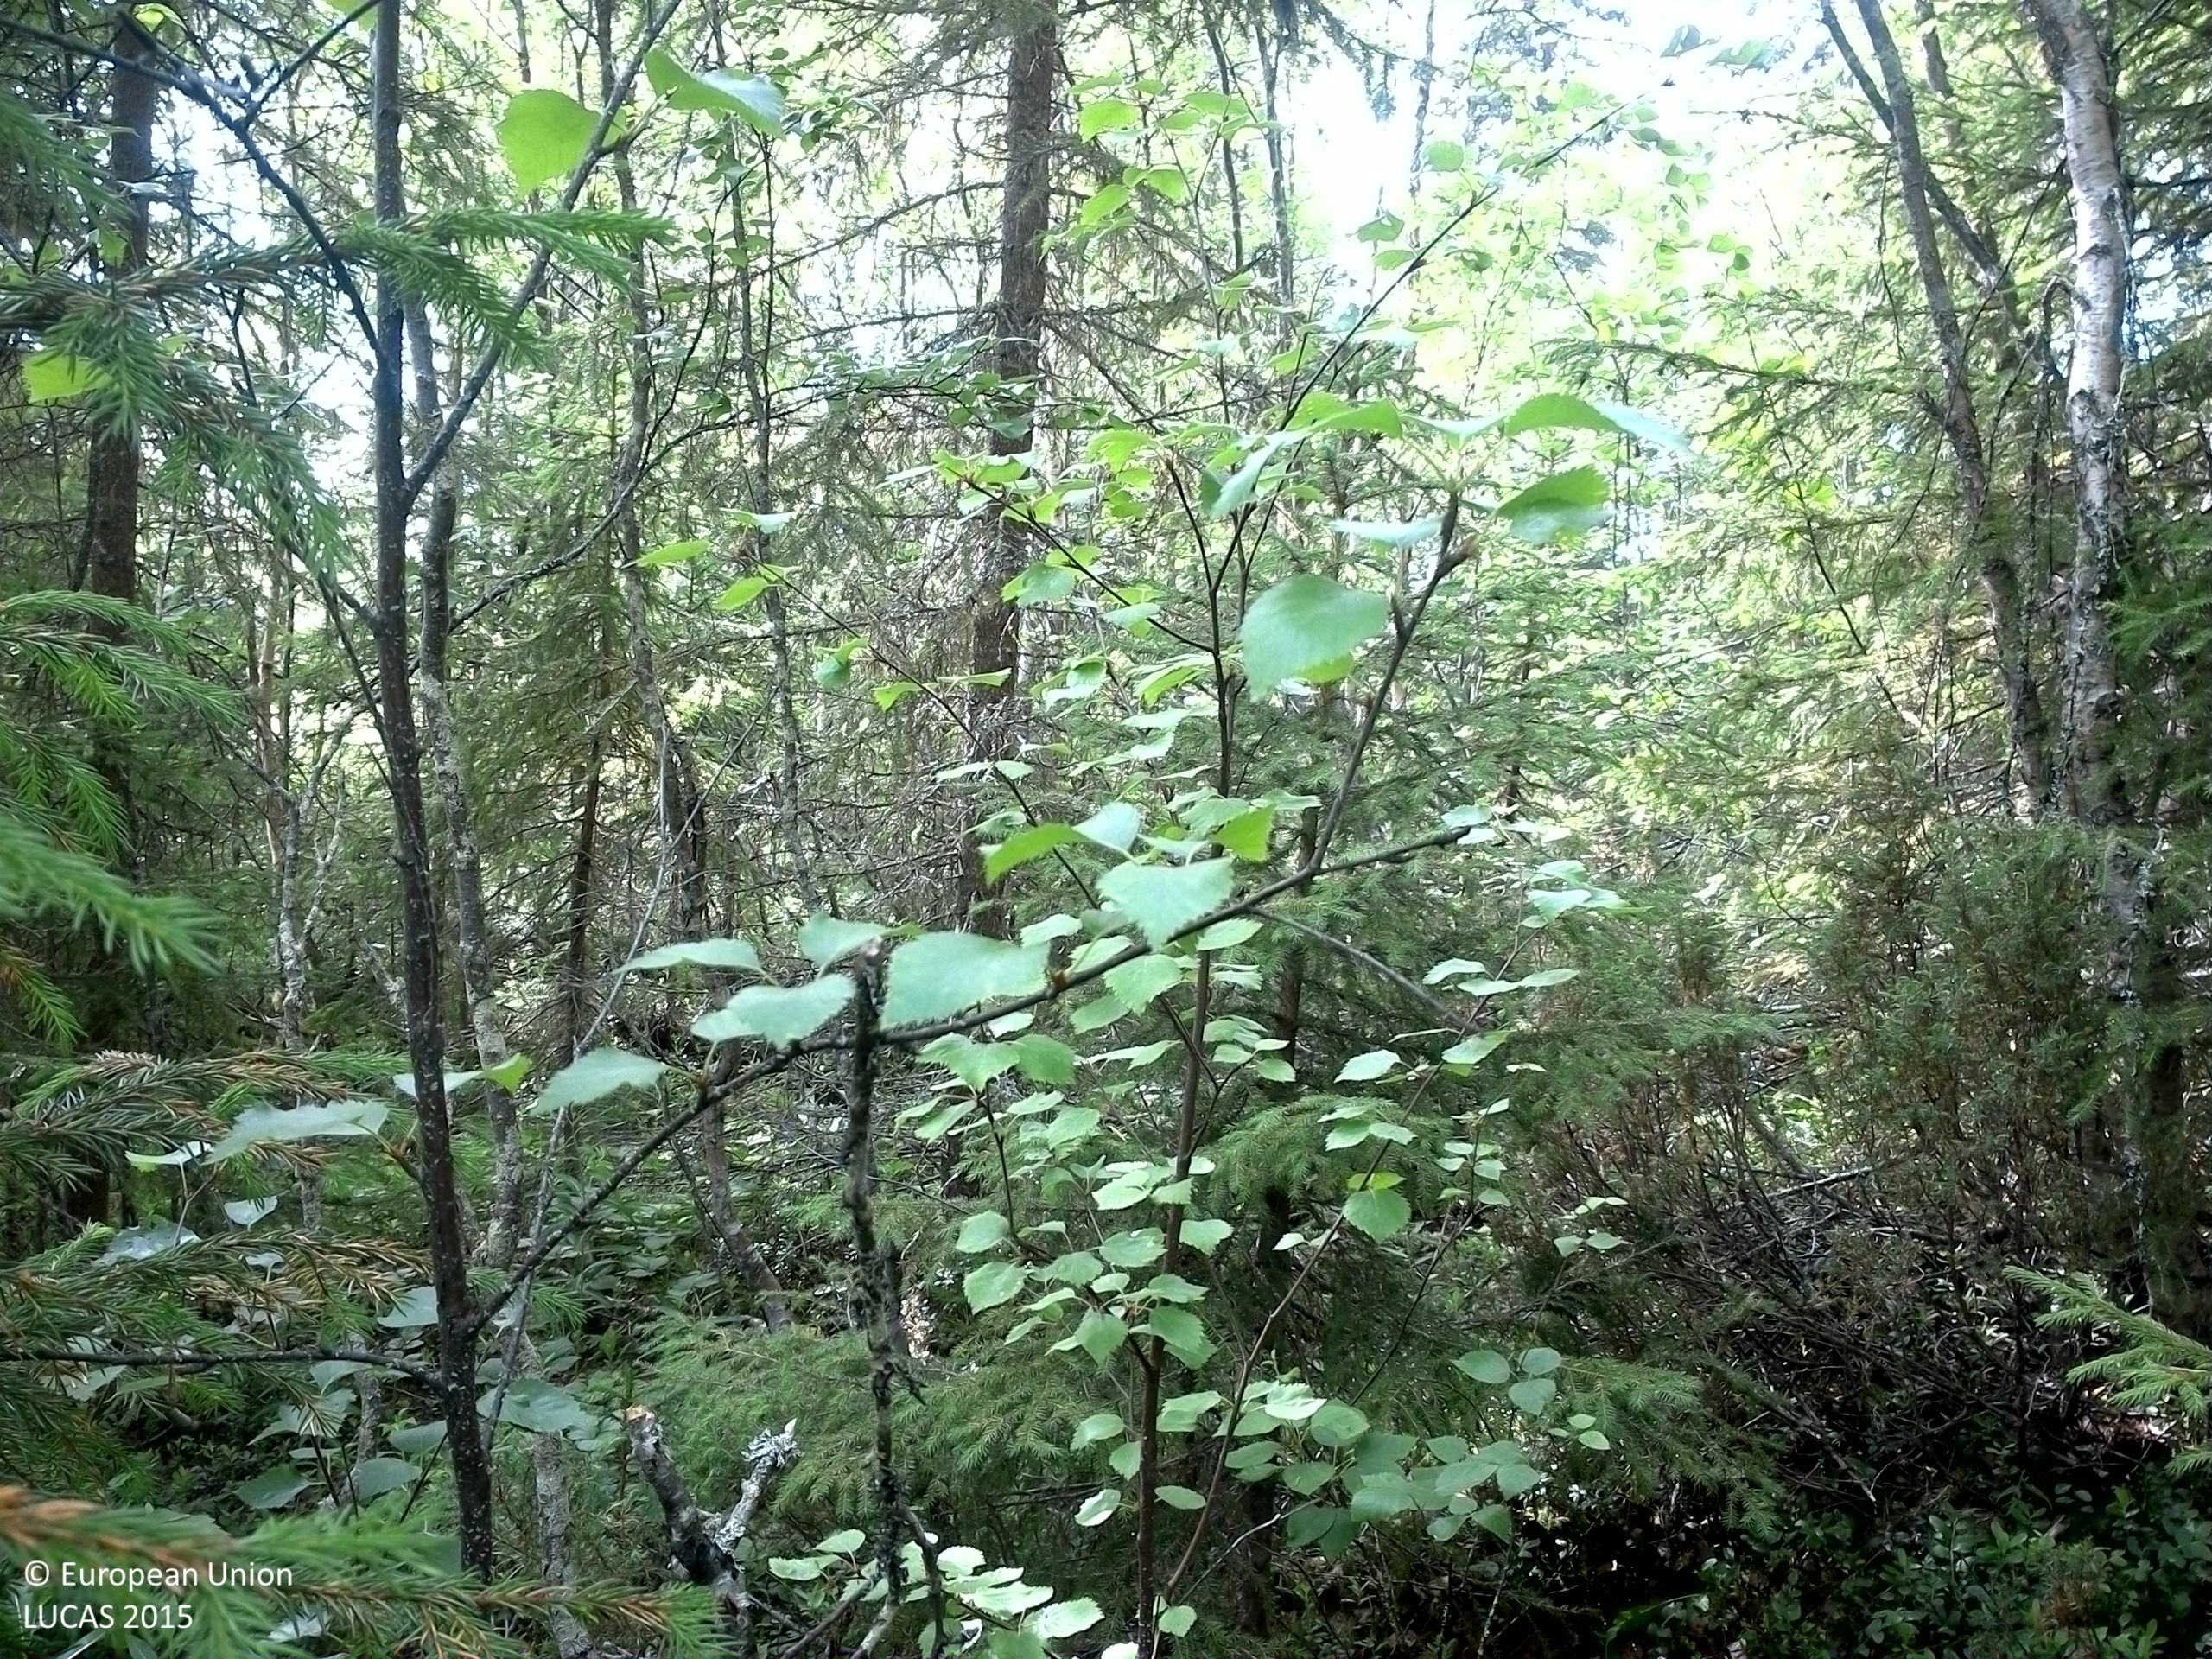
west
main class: Woodland
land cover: Other mixed woodland
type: boreal forest
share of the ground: > 75 %
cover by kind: broadleaved forest trees 45 %, coniferous forest trees 35 %, shrubs 10 %, lichens and mosses 5 %, unconsolidated bare surface 5 %
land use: Forestry
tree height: > 5 m
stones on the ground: < 10 %
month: July
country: SE
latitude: 64.4532
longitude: 15.8510
